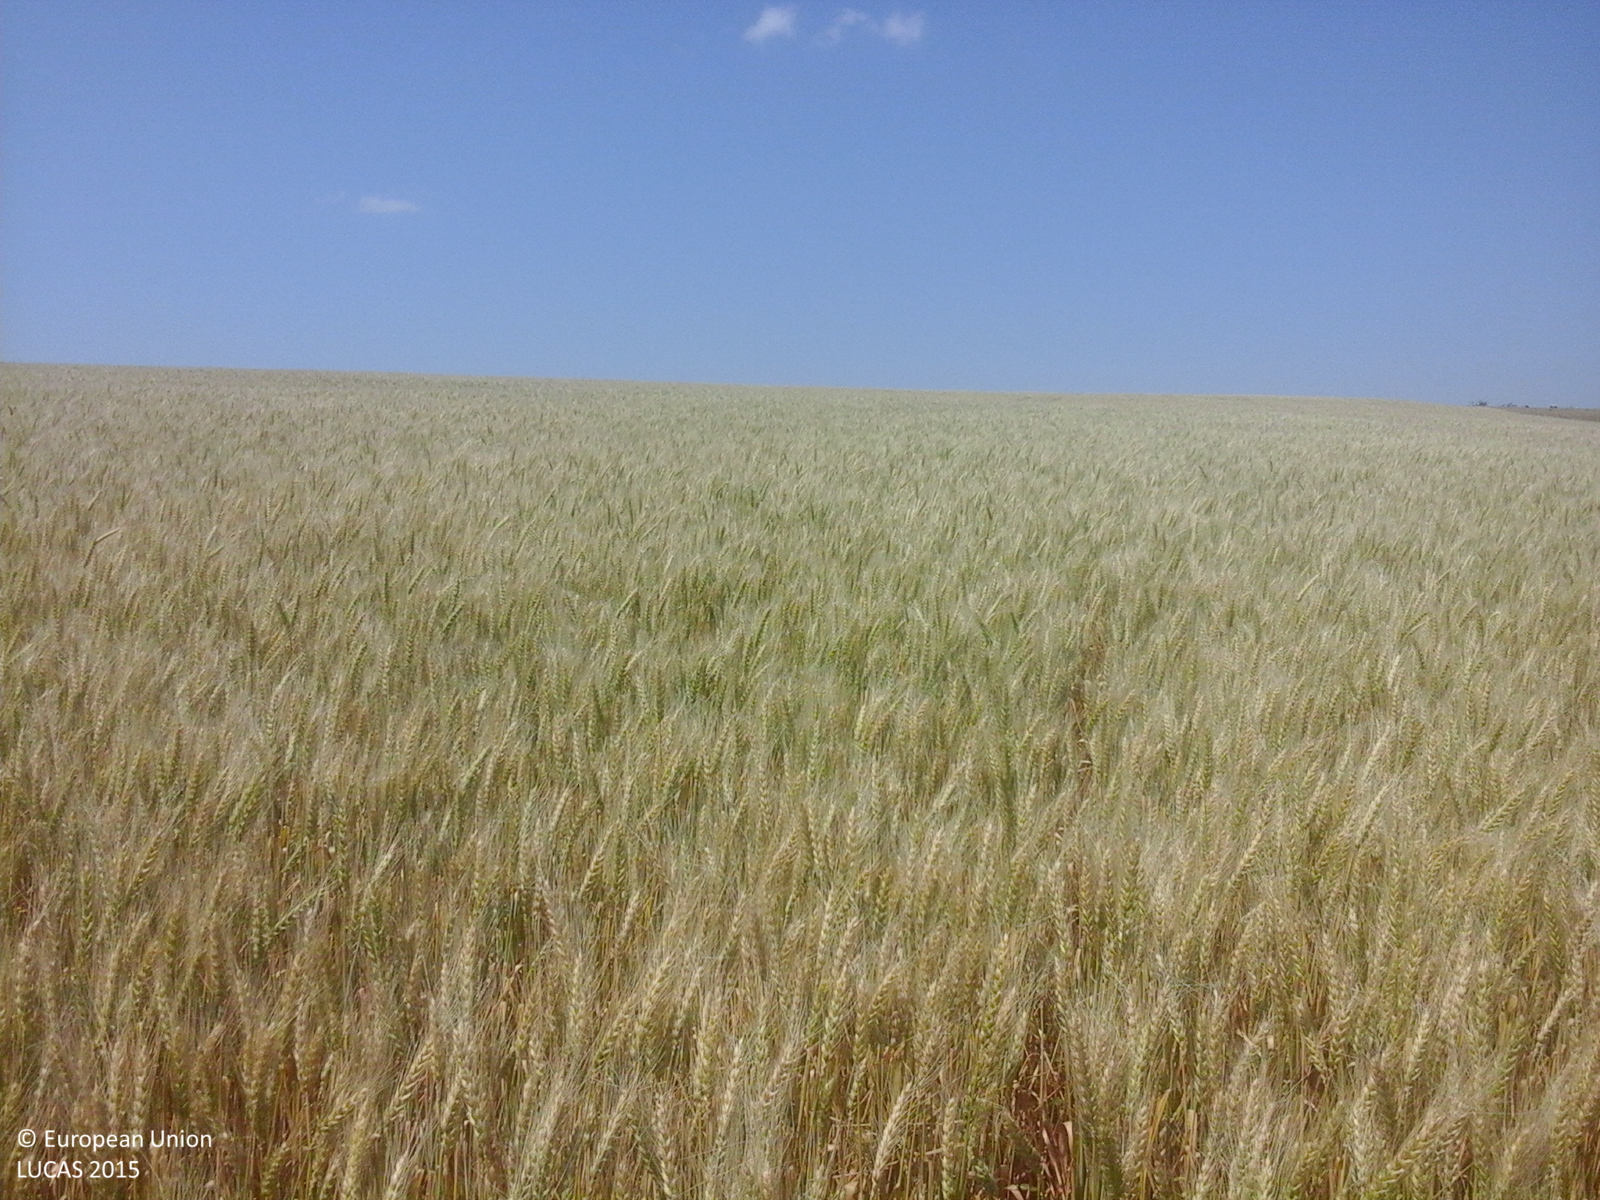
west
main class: Cropland
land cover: Common wheat
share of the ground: > 75 %
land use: Agriculture (excluding fallow land and kitchen gardens)
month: June
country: RO
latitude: 47.2467
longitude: 27.2990
